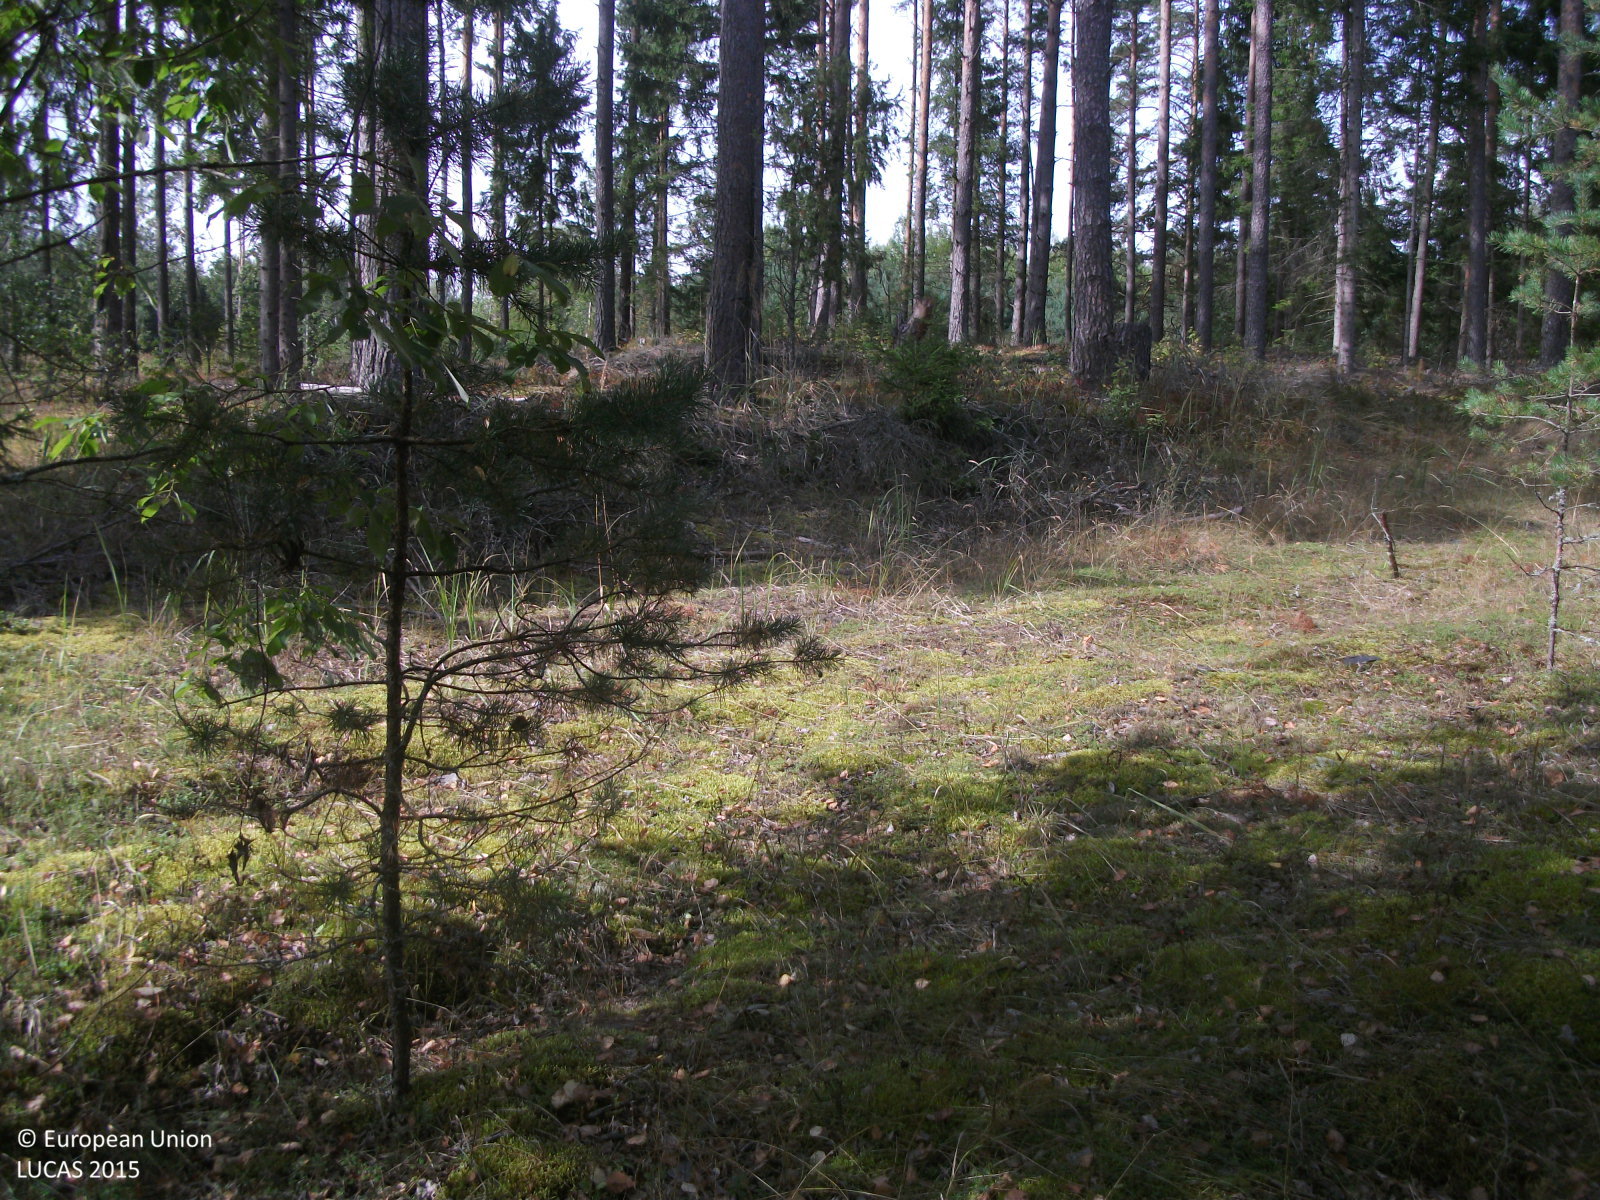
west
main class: Woodland
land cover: Pine dominated coniferous woodland
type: hemiboreal forest and nemoral coniferous forest and mixed broadleaved-coniferous forest
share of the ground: 50 - 75 %
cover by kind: coniferous forest trees 70 %, lichens and mosses 25 %, herbaceous plants 5 %
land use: Forestry
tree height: > 5 m
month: September
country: LV
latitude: 56.5760
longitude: 26.1047
